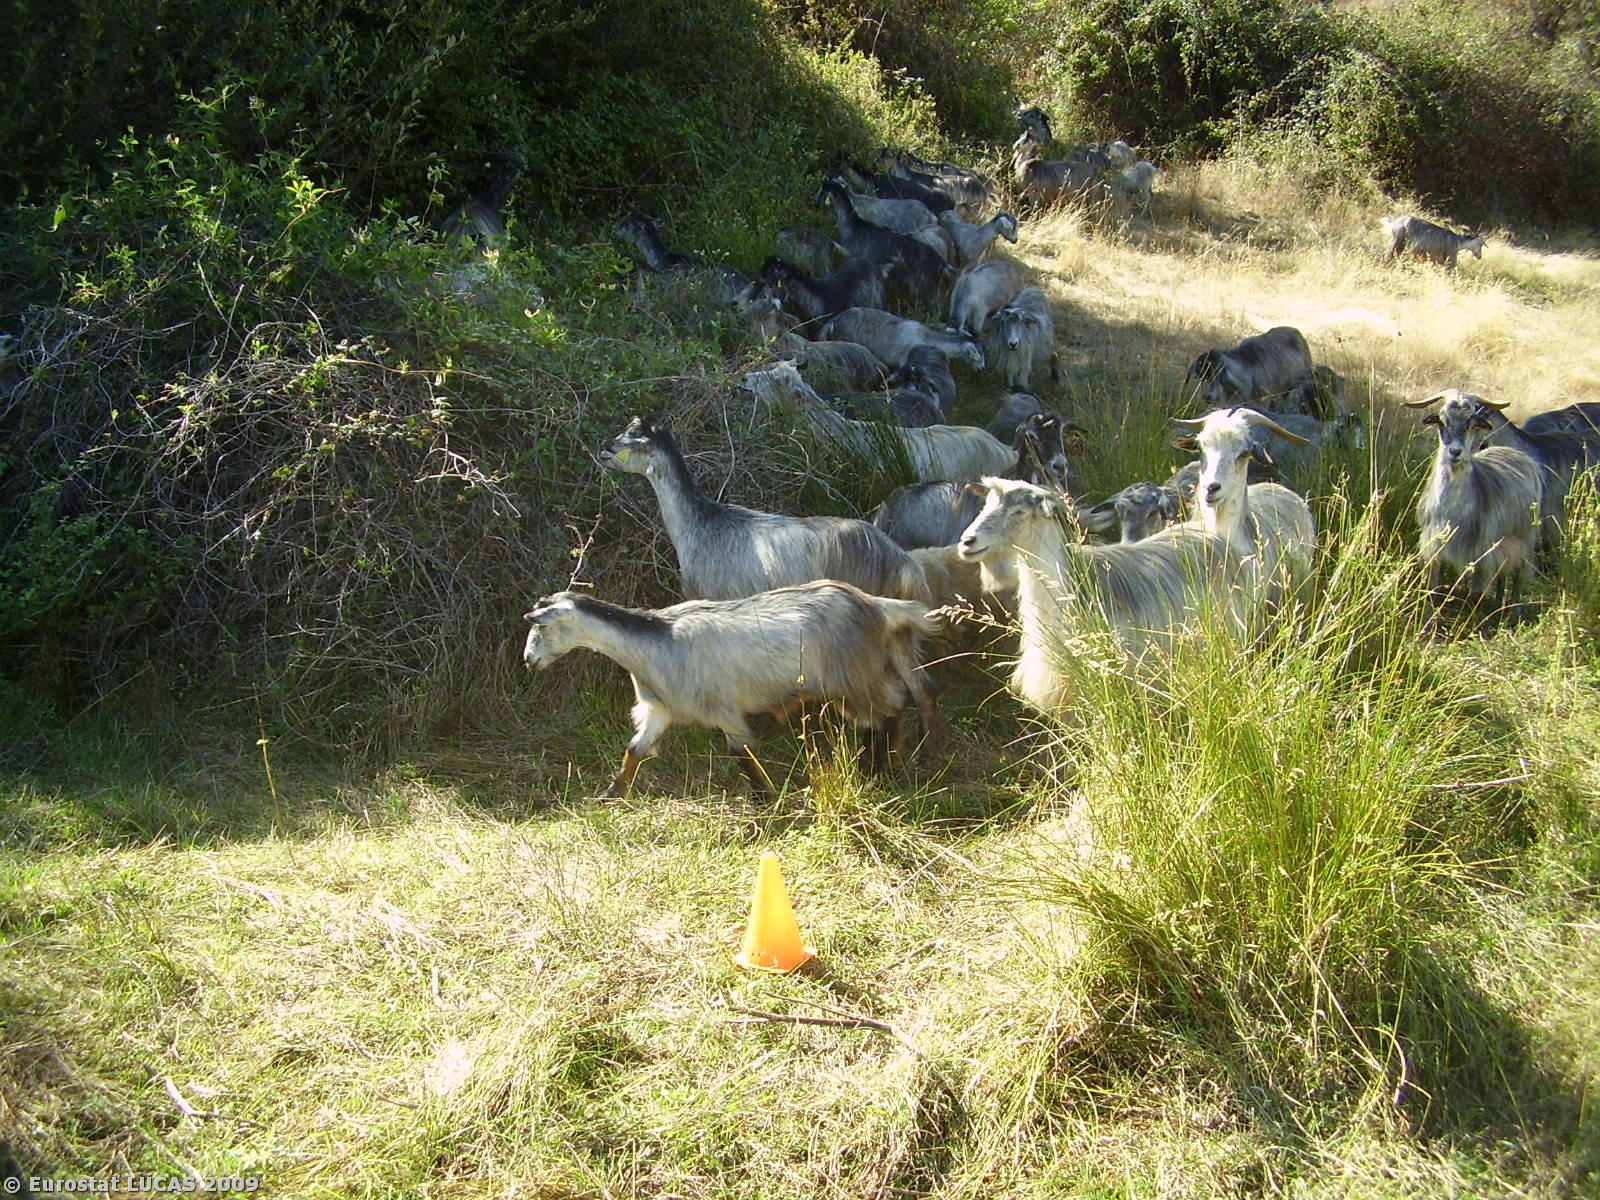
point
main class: Grassland
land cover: Spontaneously vegetated surfaces
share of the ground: > 75 %
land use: Fallow land
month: August
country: PT
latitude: 41.2784
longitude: -6.7846
